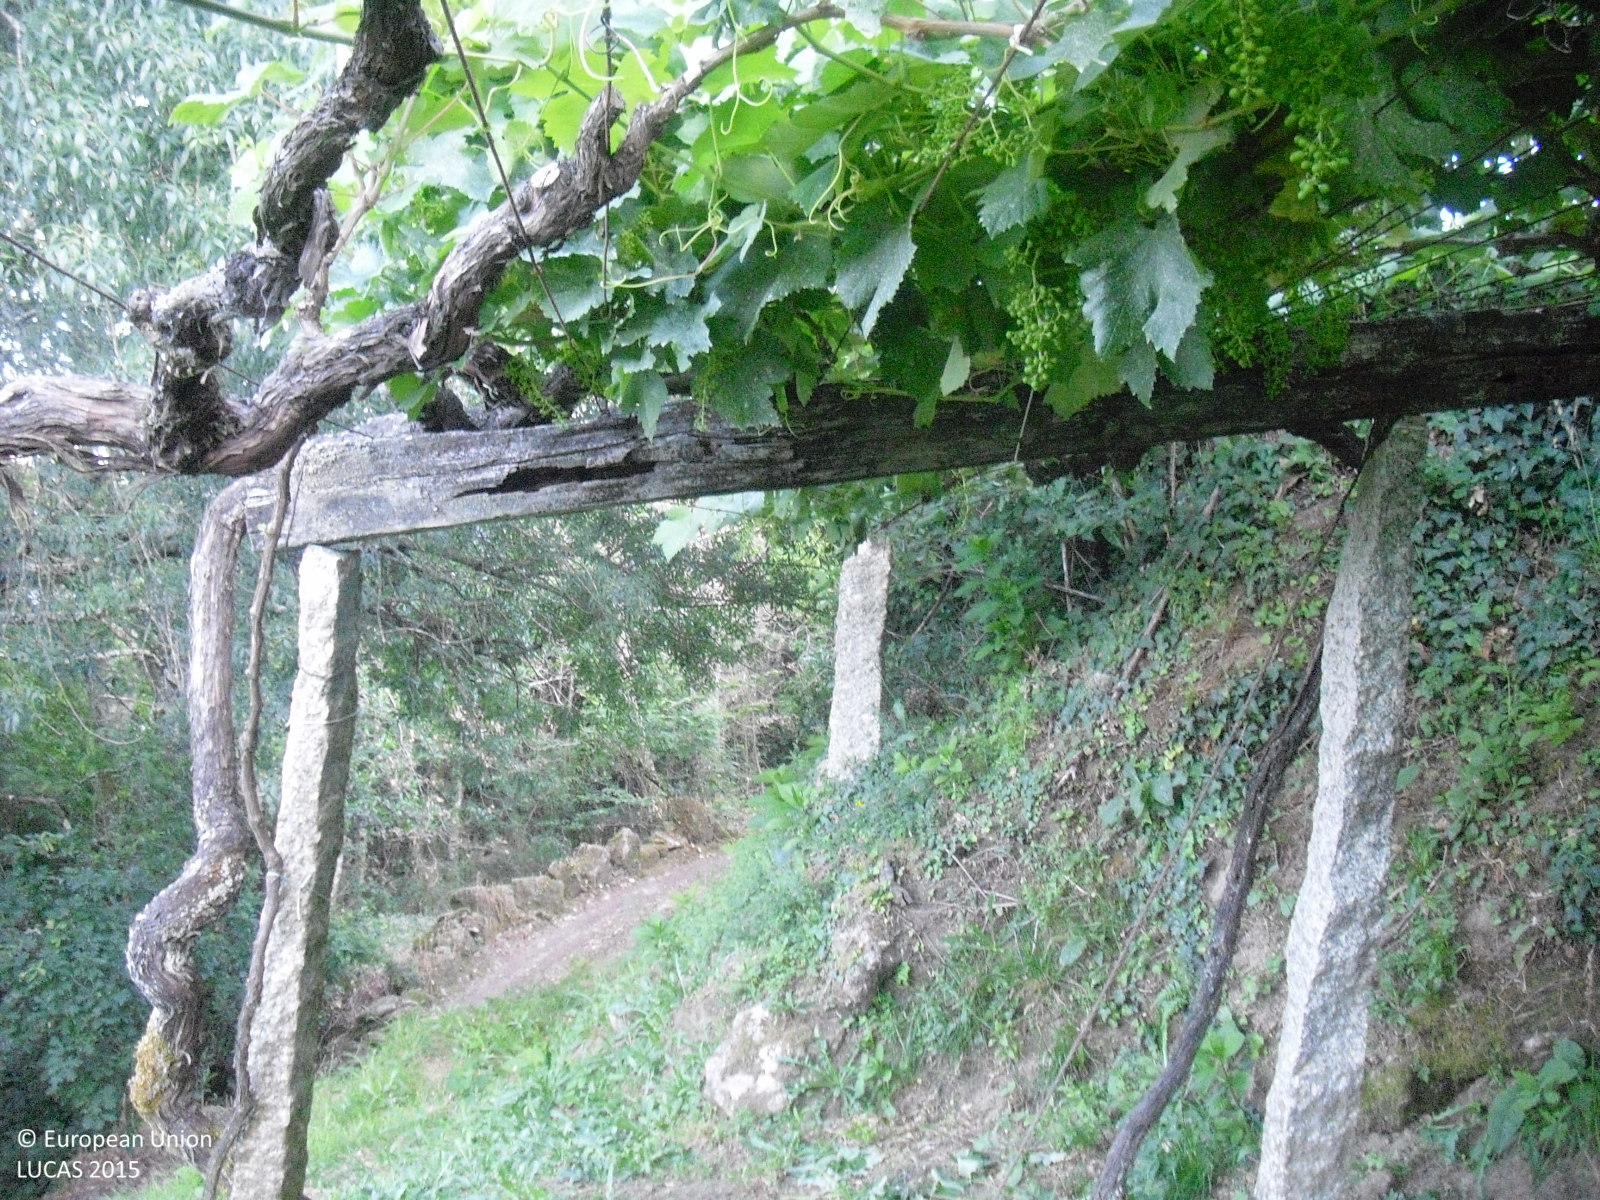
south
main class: Cropland
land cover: Vineyards
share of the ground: > 75 %
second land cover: Grassland without tree/shrub cover
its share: > 75 %
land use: Agriculture (excluding fallow land and kitchen gardens)
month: June
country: ES
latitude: 42.1432
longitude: -8.2475
